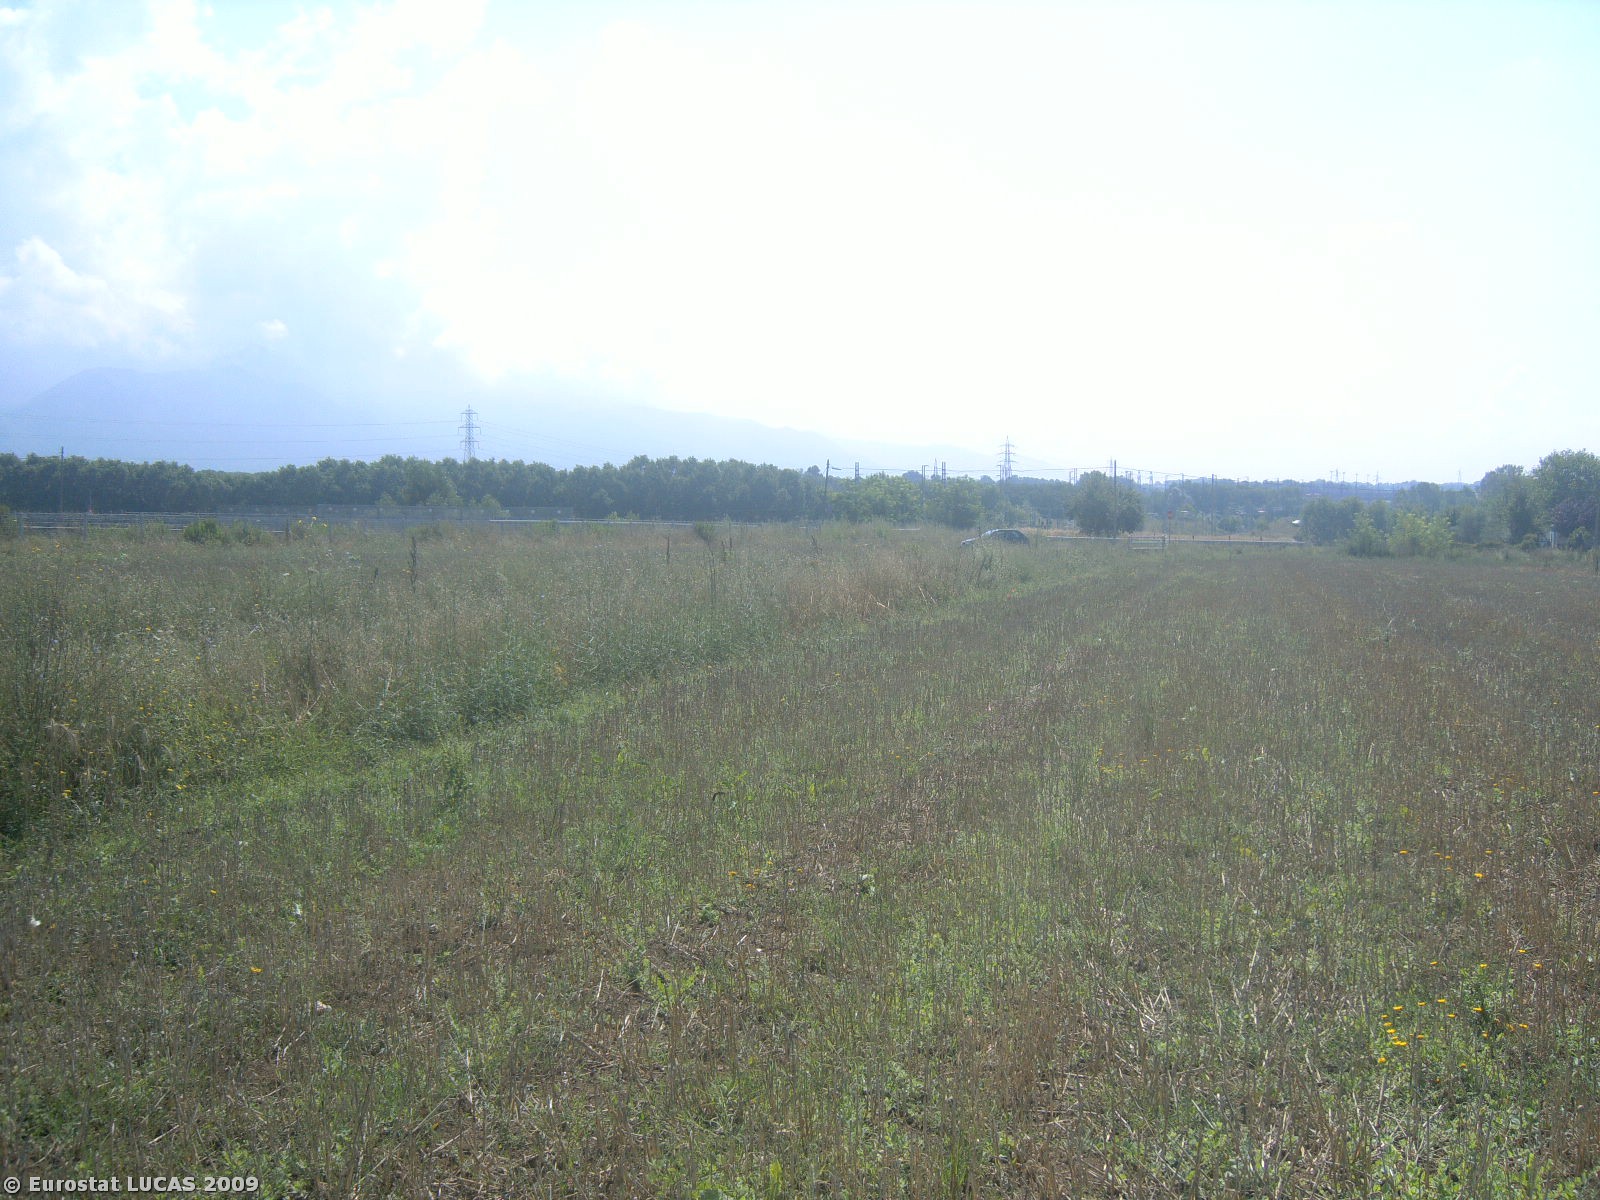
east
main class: Cropland
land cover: Common wheat
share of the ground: > 75 %
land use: Agriculture (excluding fallow land and kitchen gardens)
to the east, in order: Common wheat; Grass margins; Paved roads, cycling and walking lanes; Grass margins; Common wheat; Grass margins; Fences; Shrubland without tree cover; Paved roads, cycling and walking lanes; Shrubland with sparse tree cover; Fences; Grass margins; Mixed cereals for fodder
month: July
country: IT
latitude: 41.5232
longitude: 13.5934
